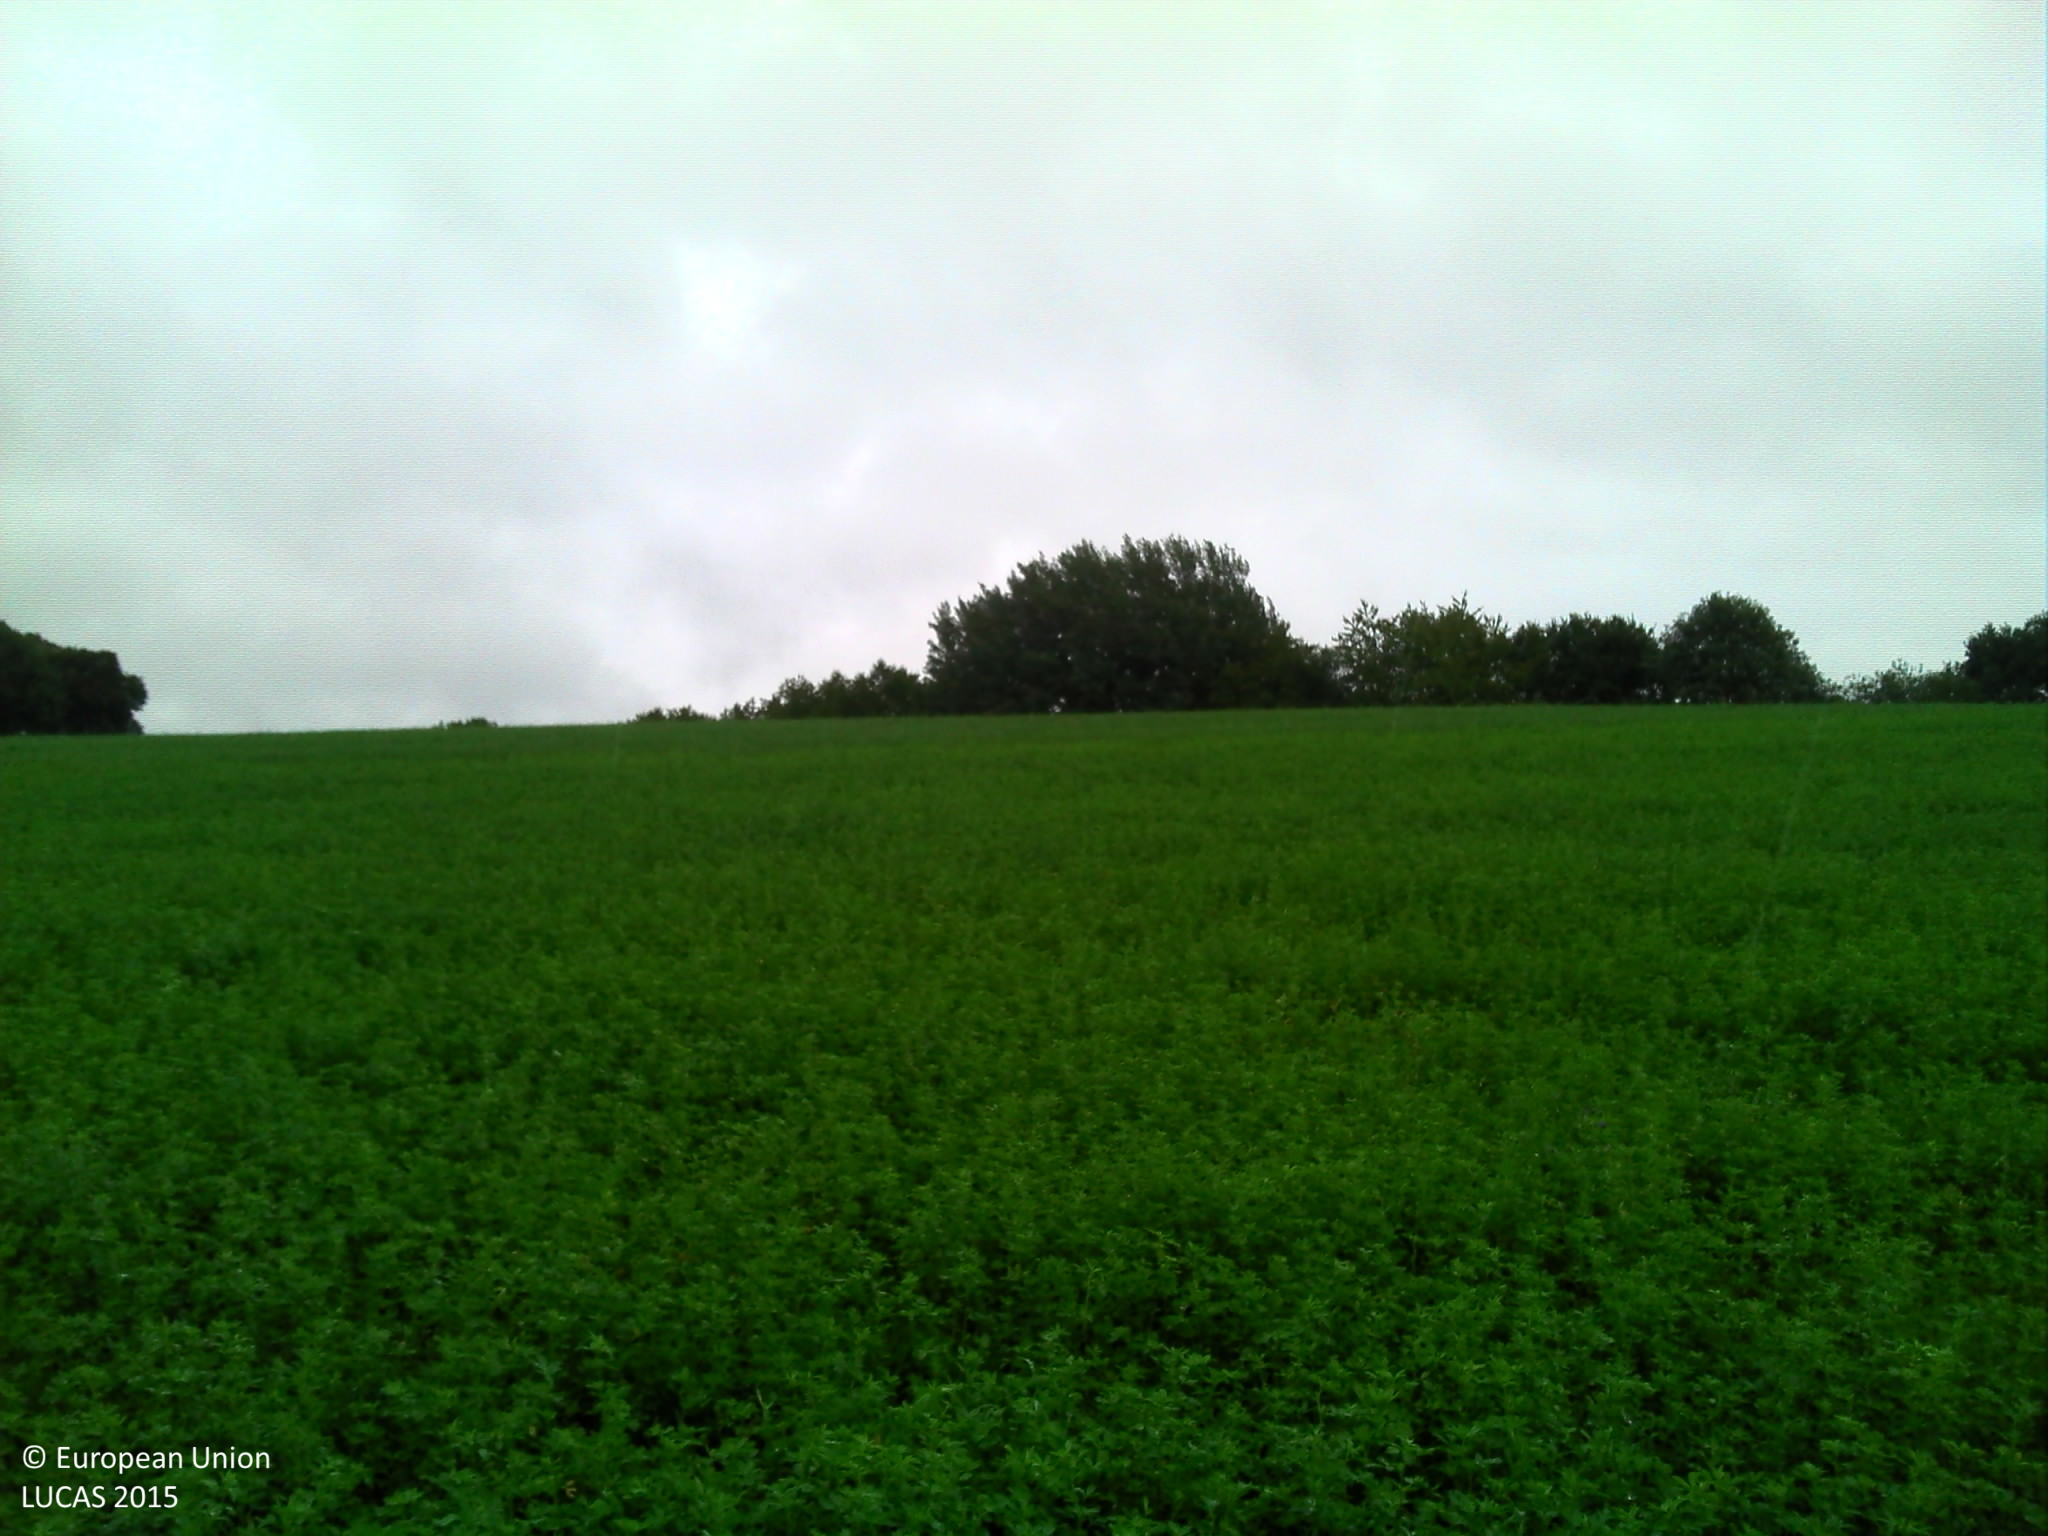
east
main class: Cropland
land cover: Lucerne
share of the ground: > 75 %
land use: Agriculture (excluding fallow land and kitchen gardens)
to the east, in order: Lucerne; Temporary grasslands; Ditches and canals; Grass margins; Paved roads, cycling and walking lanes; Grass margins; Broadleaved woodland; Maize
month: September
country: LU
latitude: 49.7855
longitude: 5.8739
